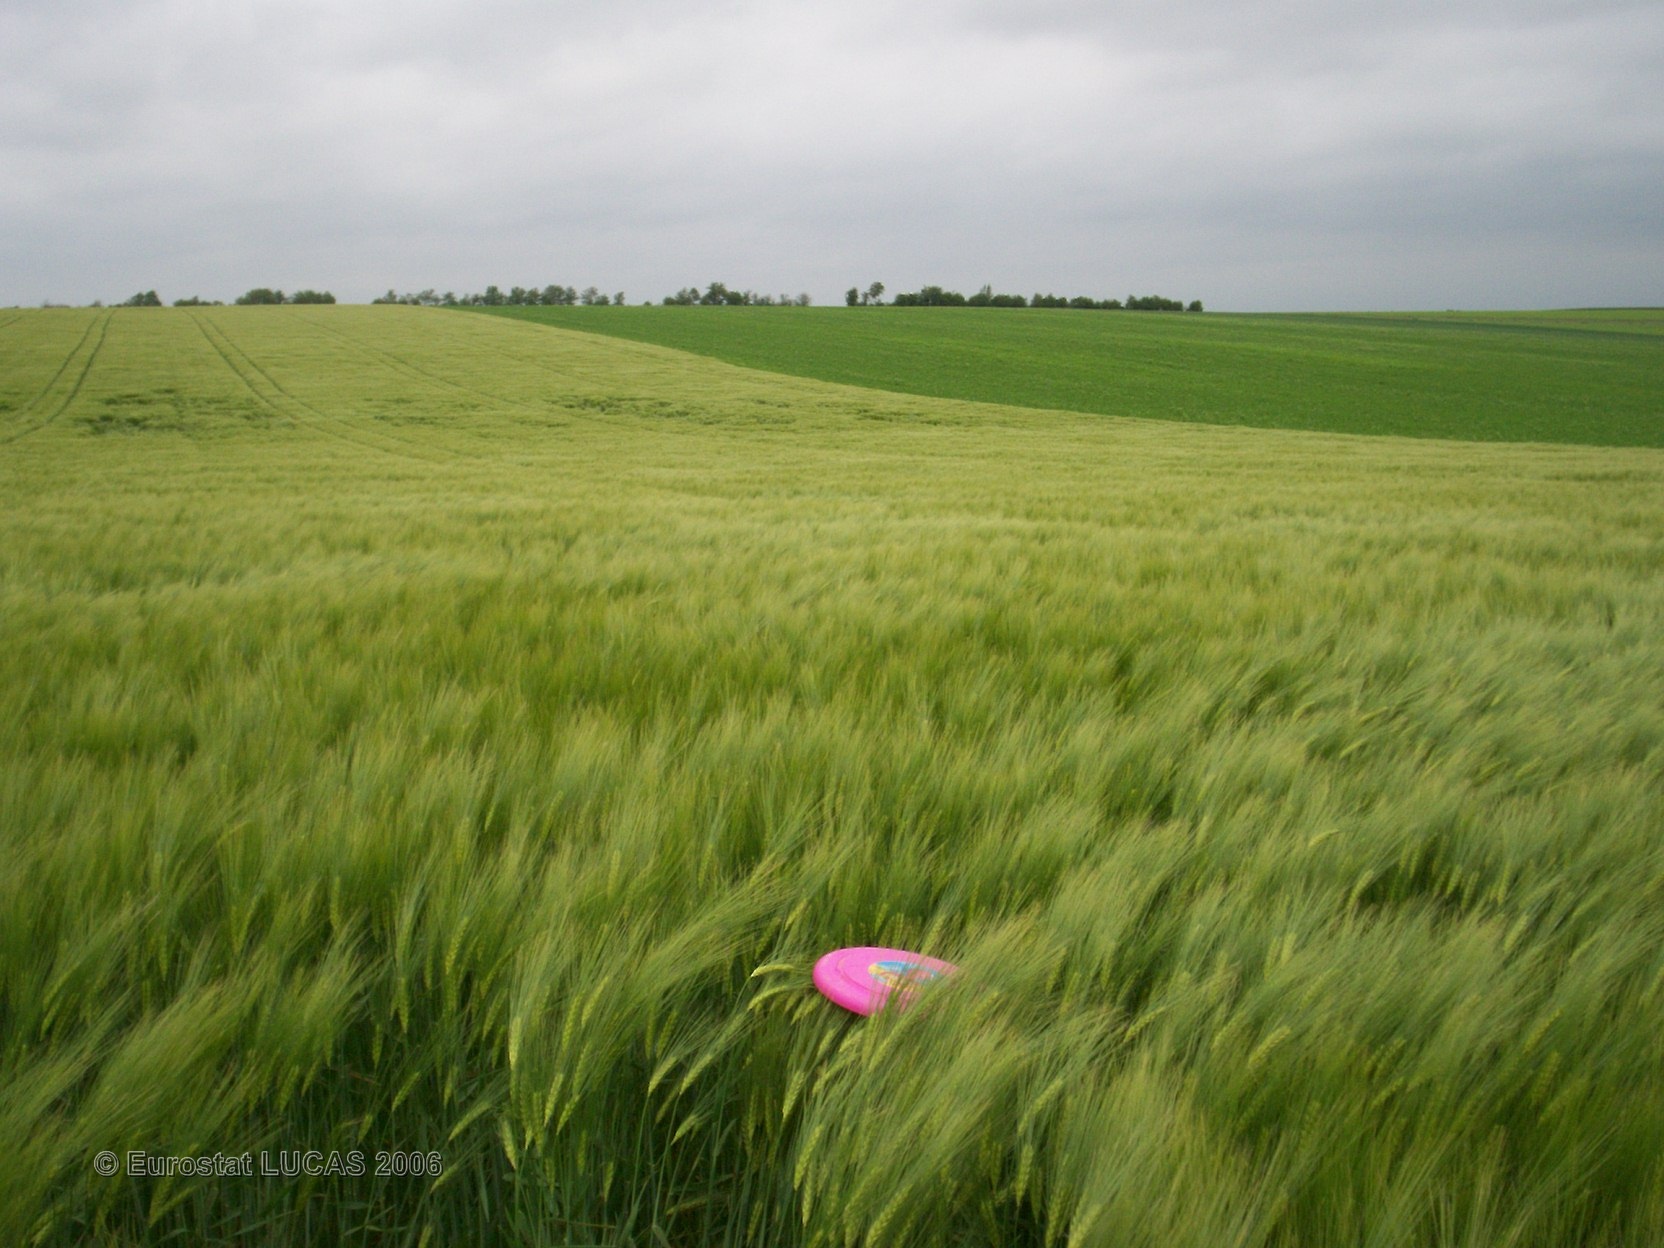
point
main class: Cropland
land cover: Barley
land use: Agriculture (excluding fallow land and kitchen gardens)
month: May
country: FR
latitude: 49.3447
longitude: 4.4216
